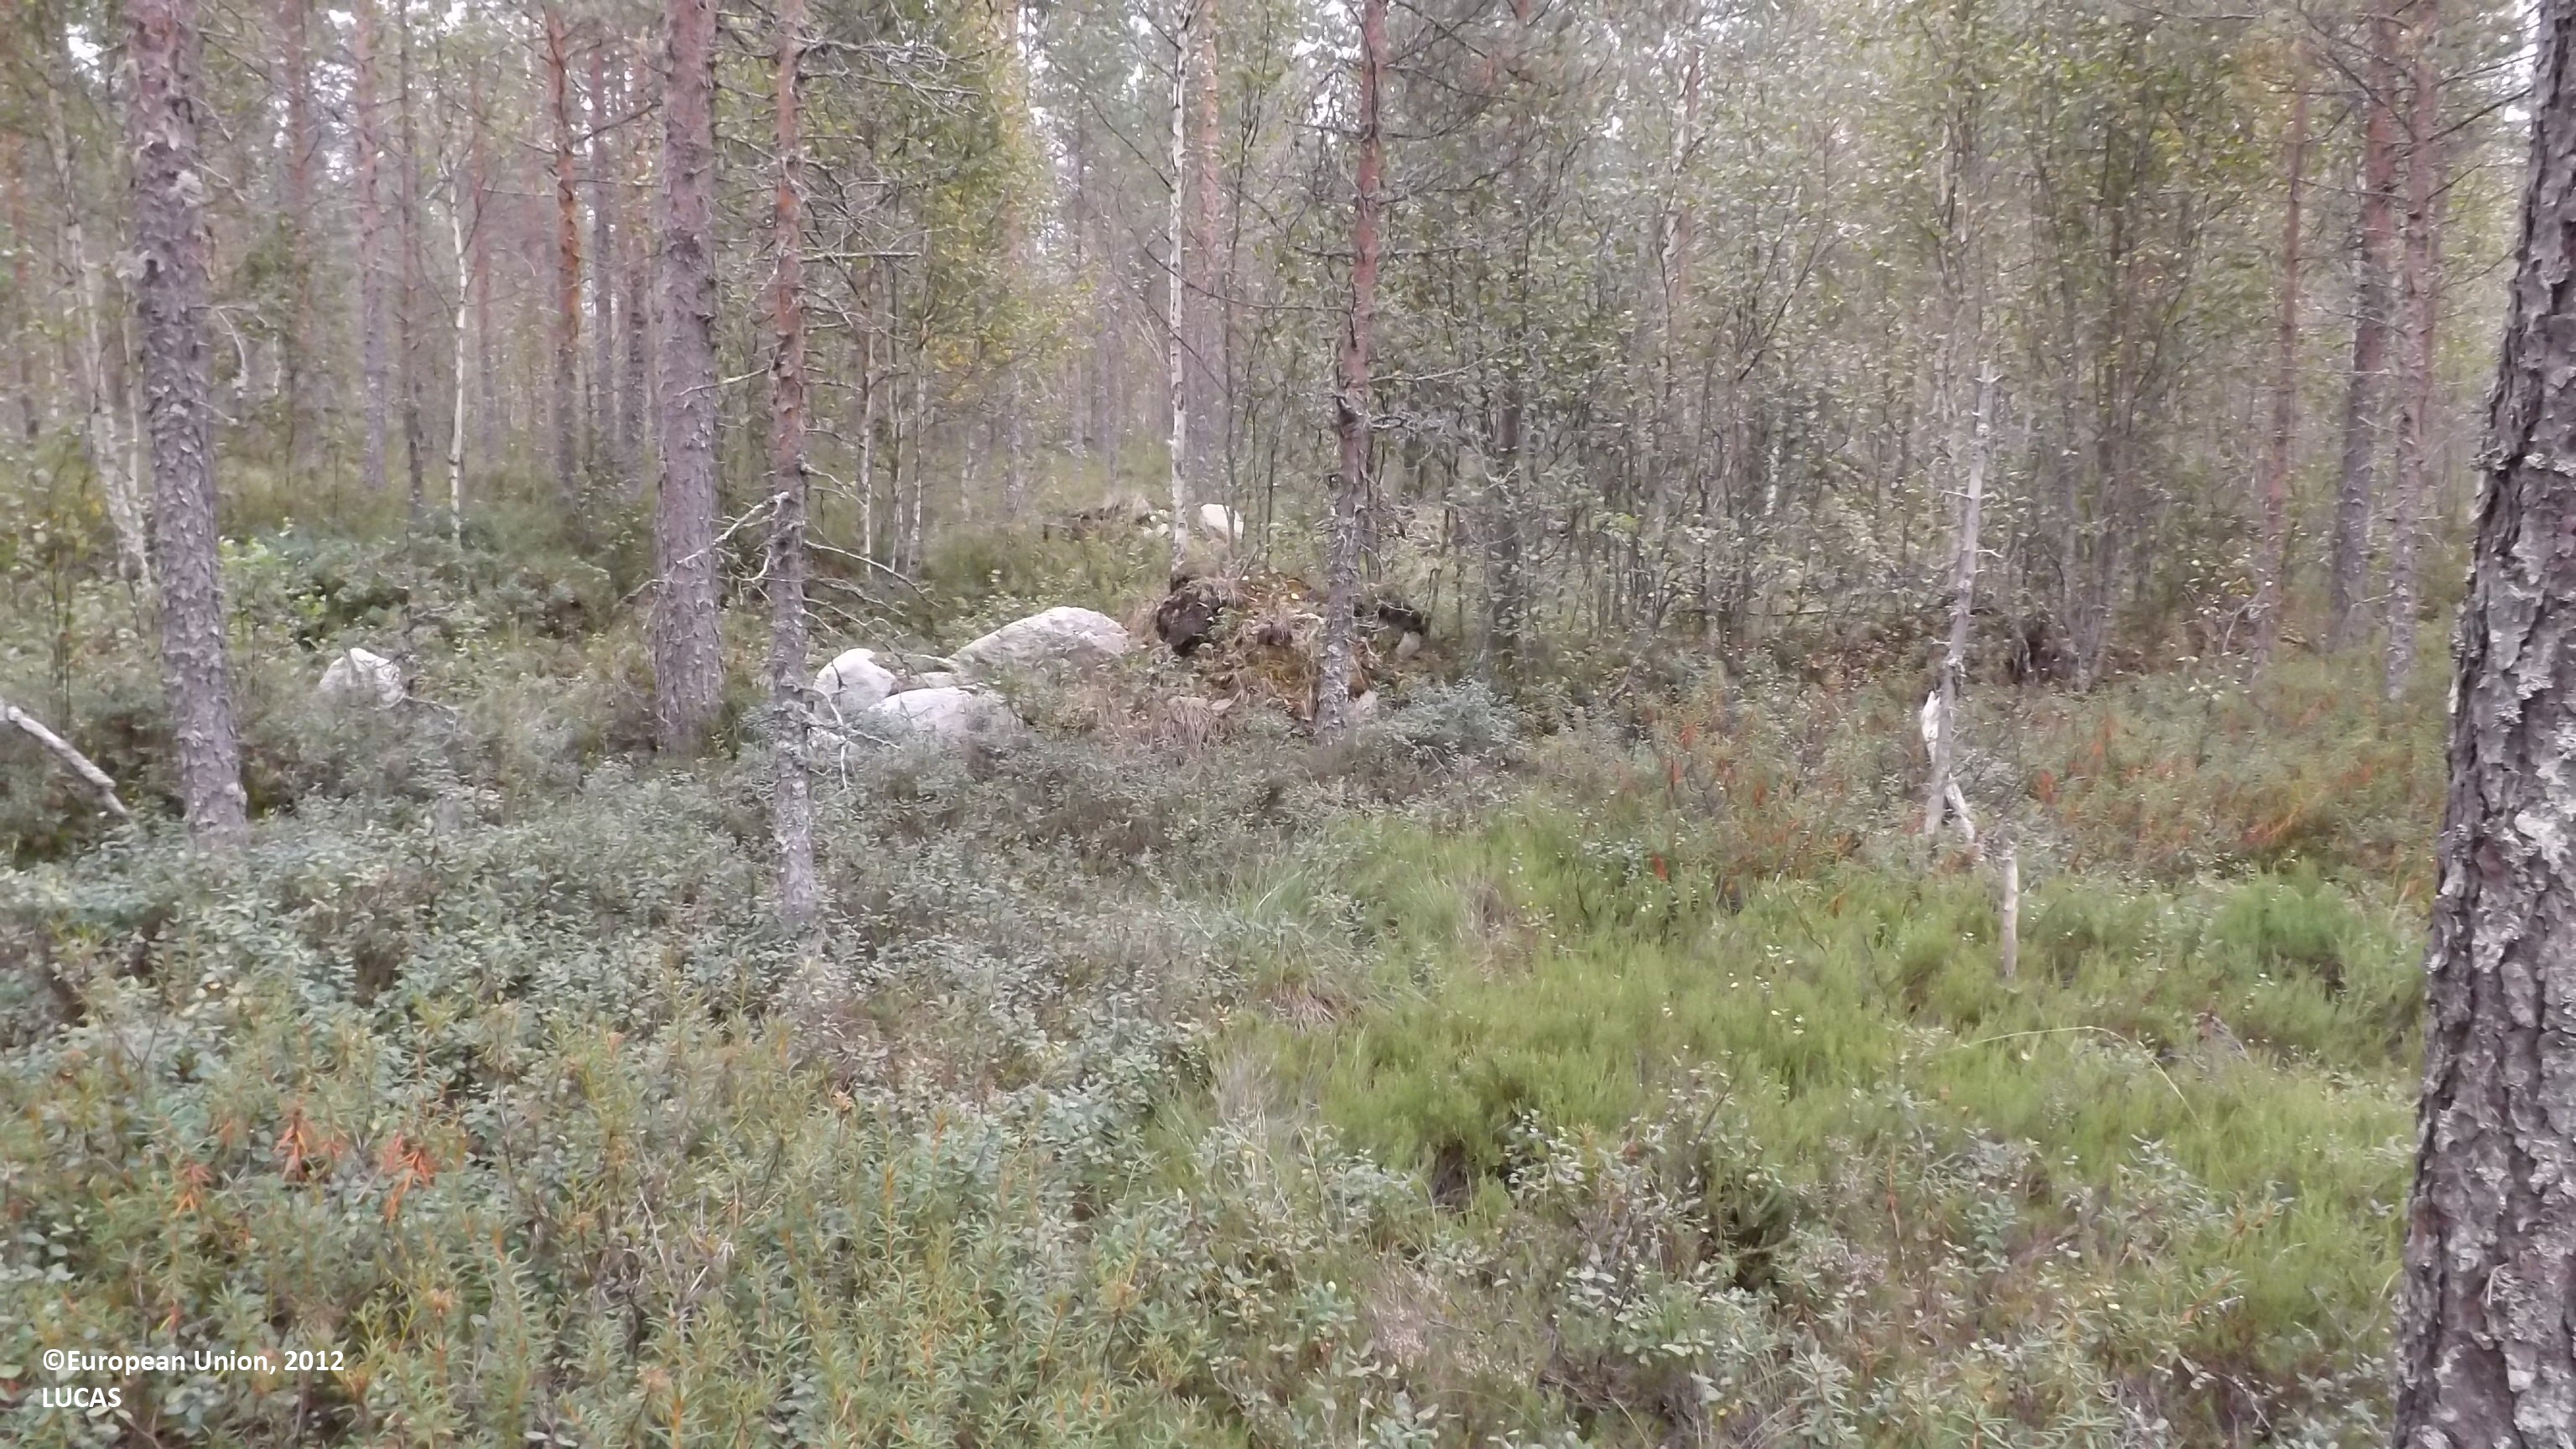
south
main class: Woodland
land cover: Pine dominated coniferous woodland
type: boreal forest
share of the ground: 50 - 75 %
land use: Forestry
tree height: > 5 m
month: August
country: FI
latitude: 63.7525
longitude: 23.8261
